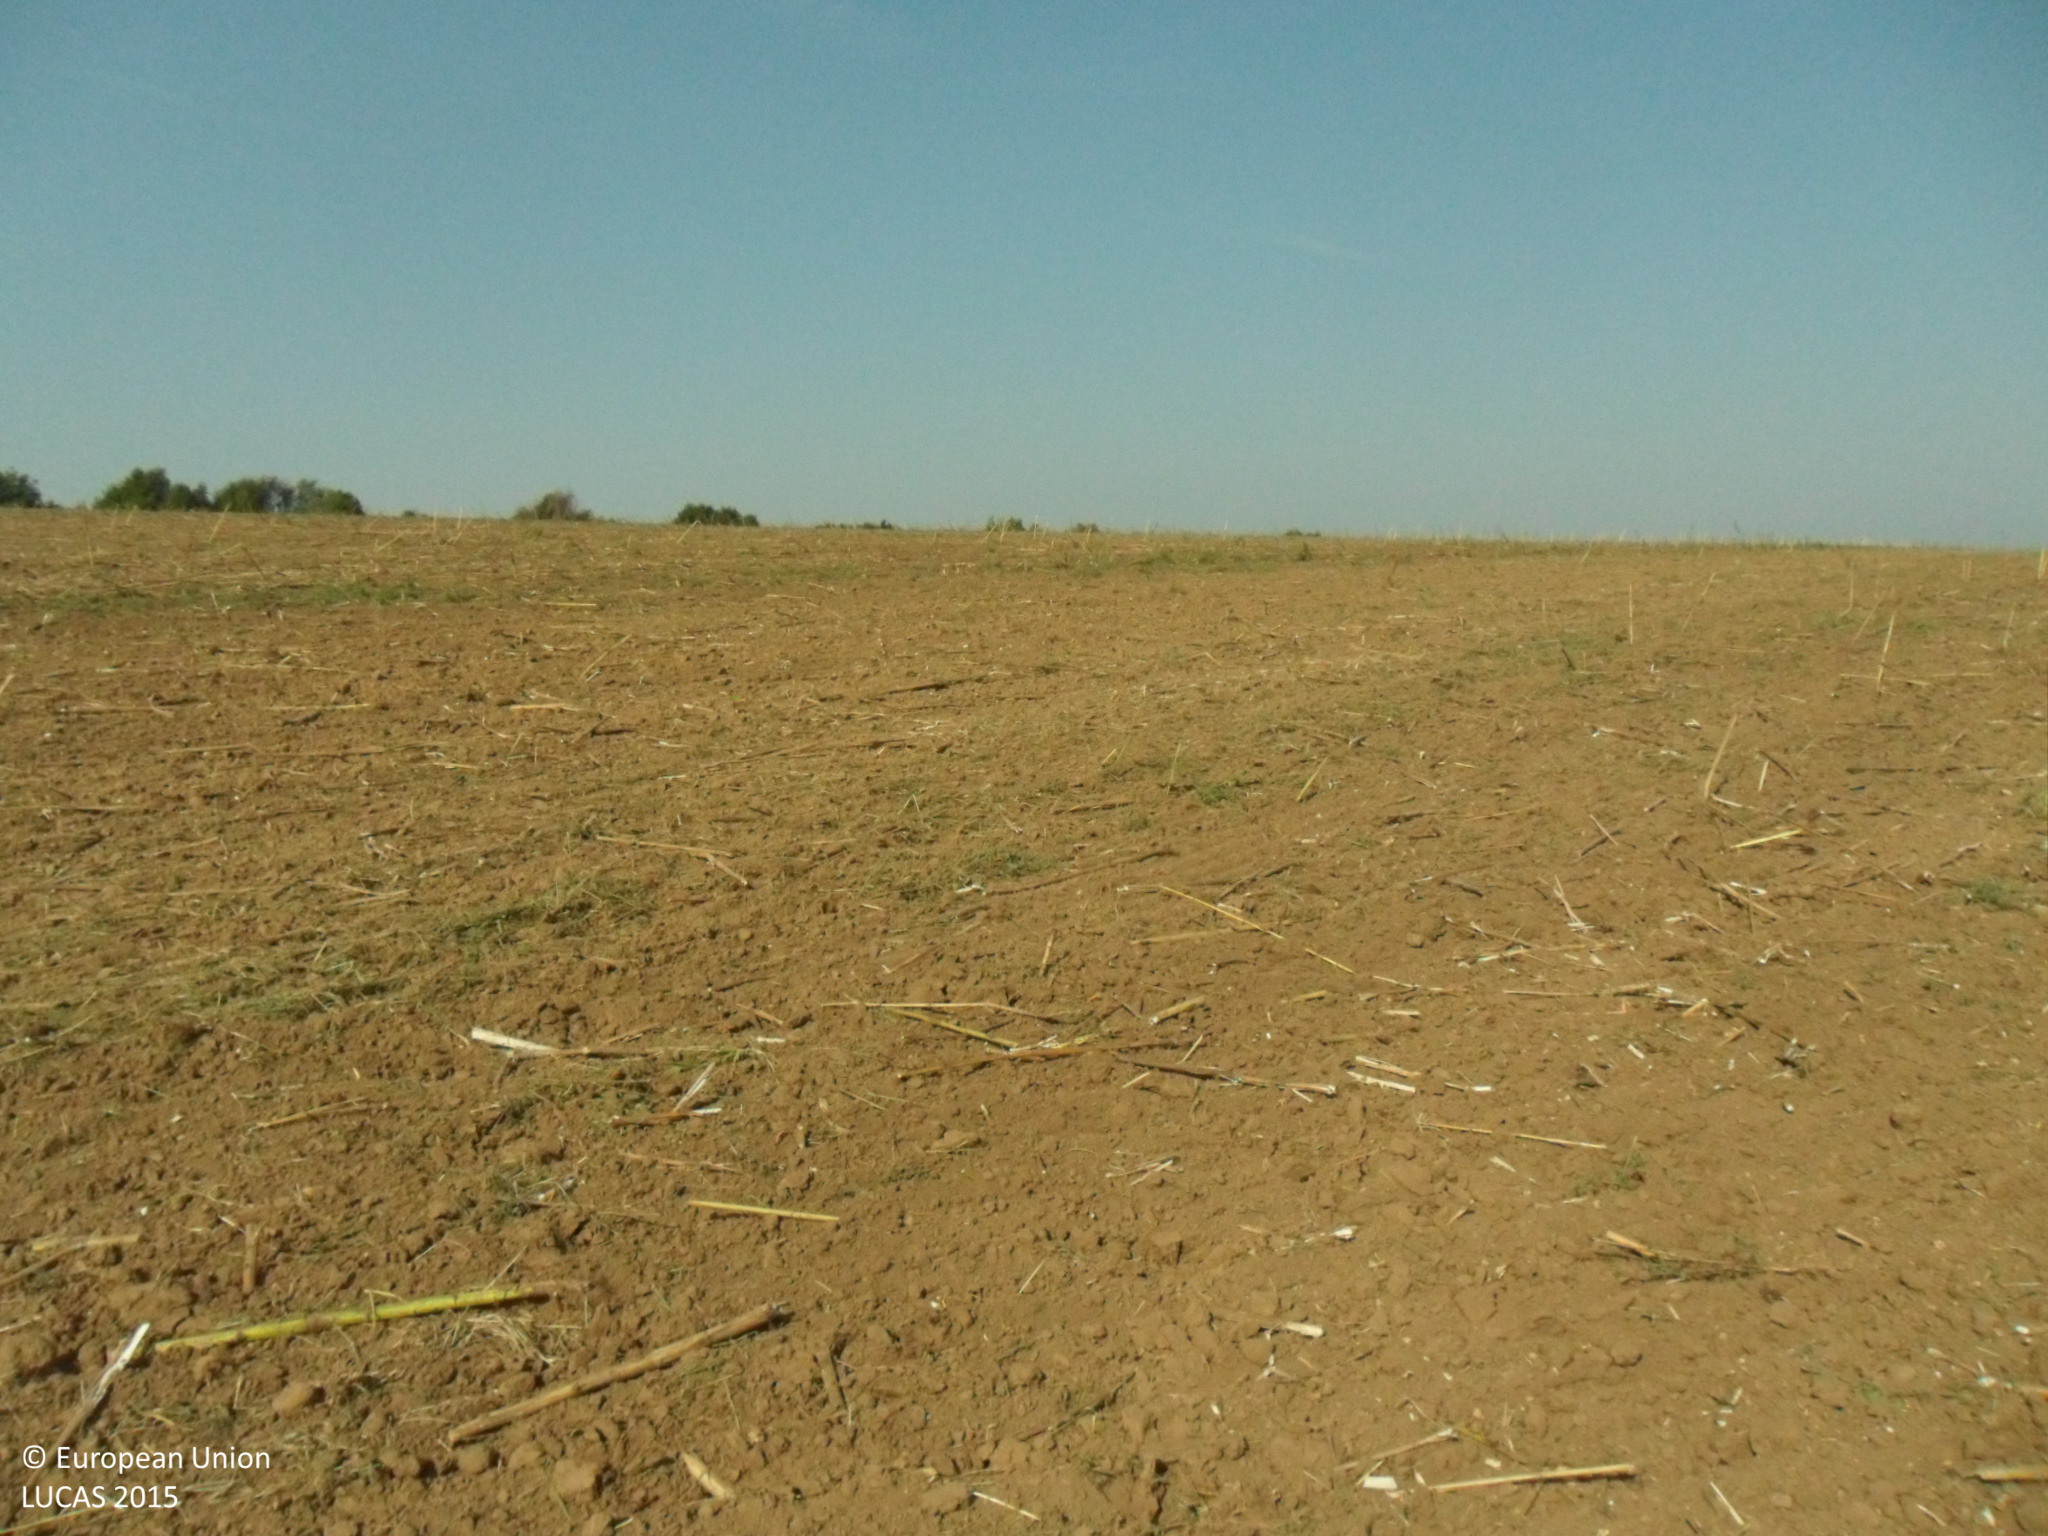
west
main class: Cropland
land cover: Sunflower
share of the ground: < 10 %
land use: Agriculture (excluding fallow land and kitchen gardens)
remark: Harvested field
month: September
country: BG
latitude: 43.6367
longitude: 26.2006
